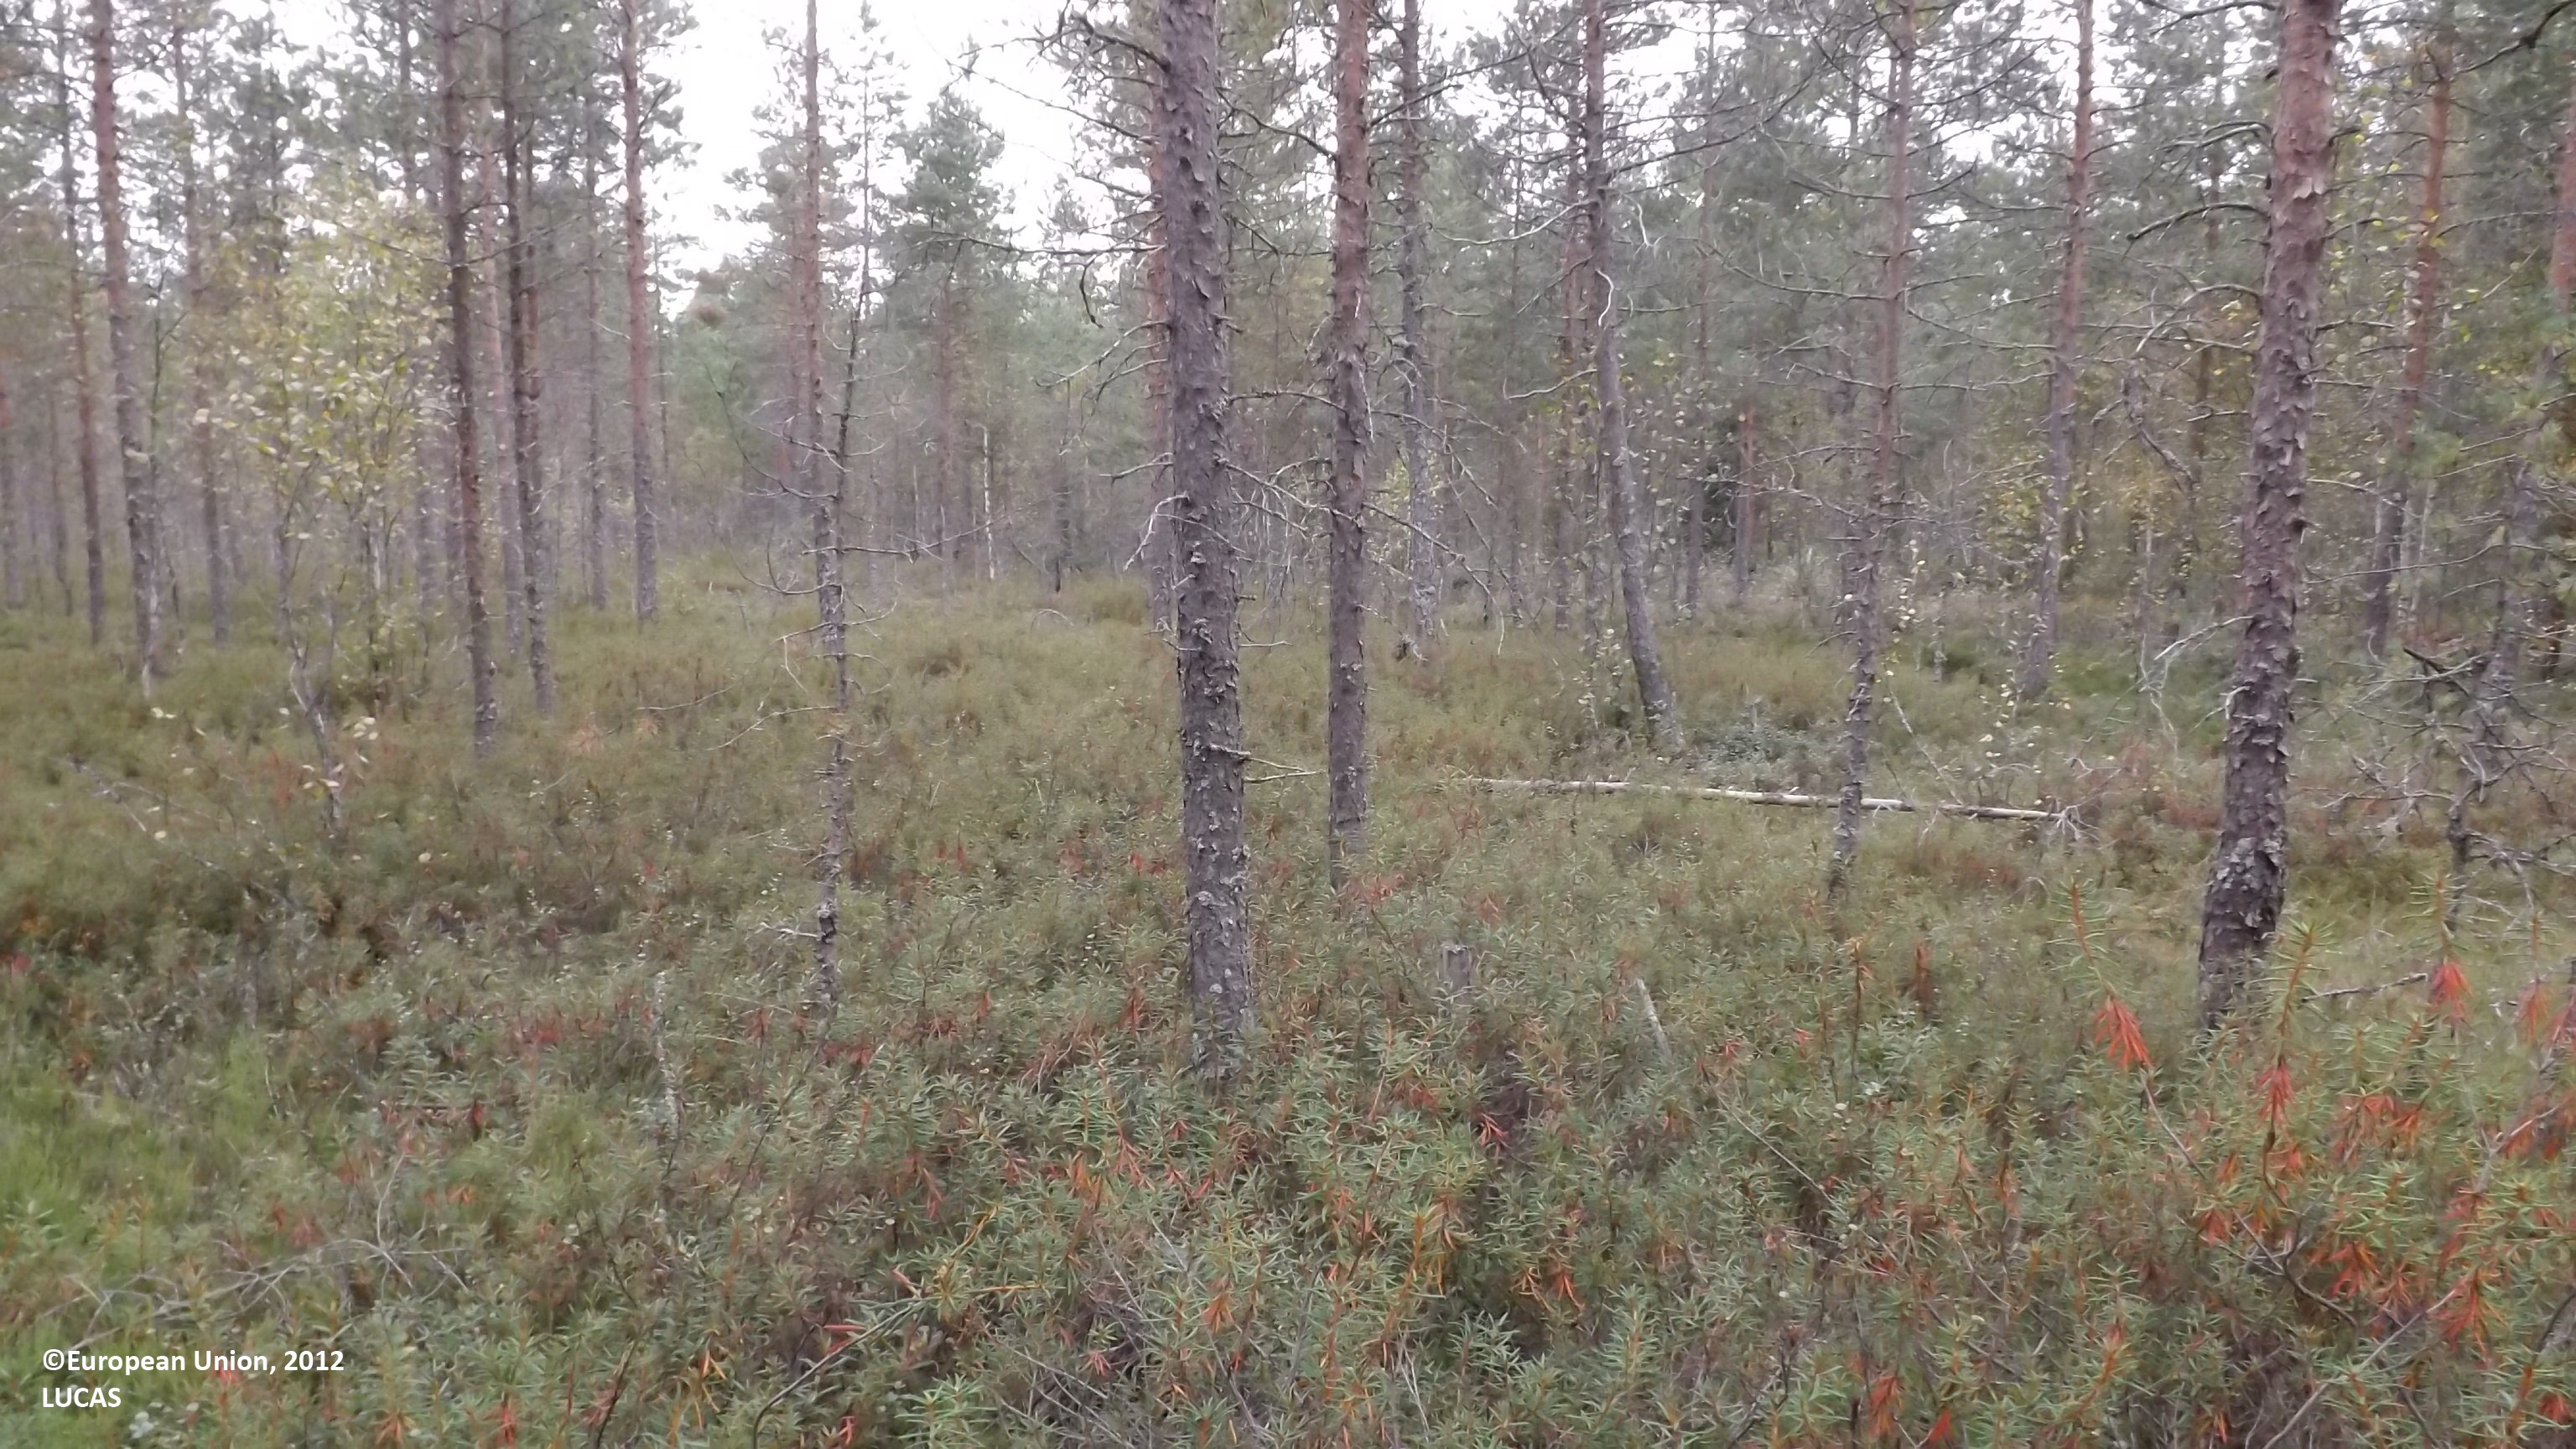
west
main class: Woodland
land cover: Pine dominated coniferous woodland
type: boreal forest
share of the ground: 50 - 75 %
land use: Forestry
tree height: > 5 m
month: August
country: FI
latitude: 63.7525
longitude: 23.8261
